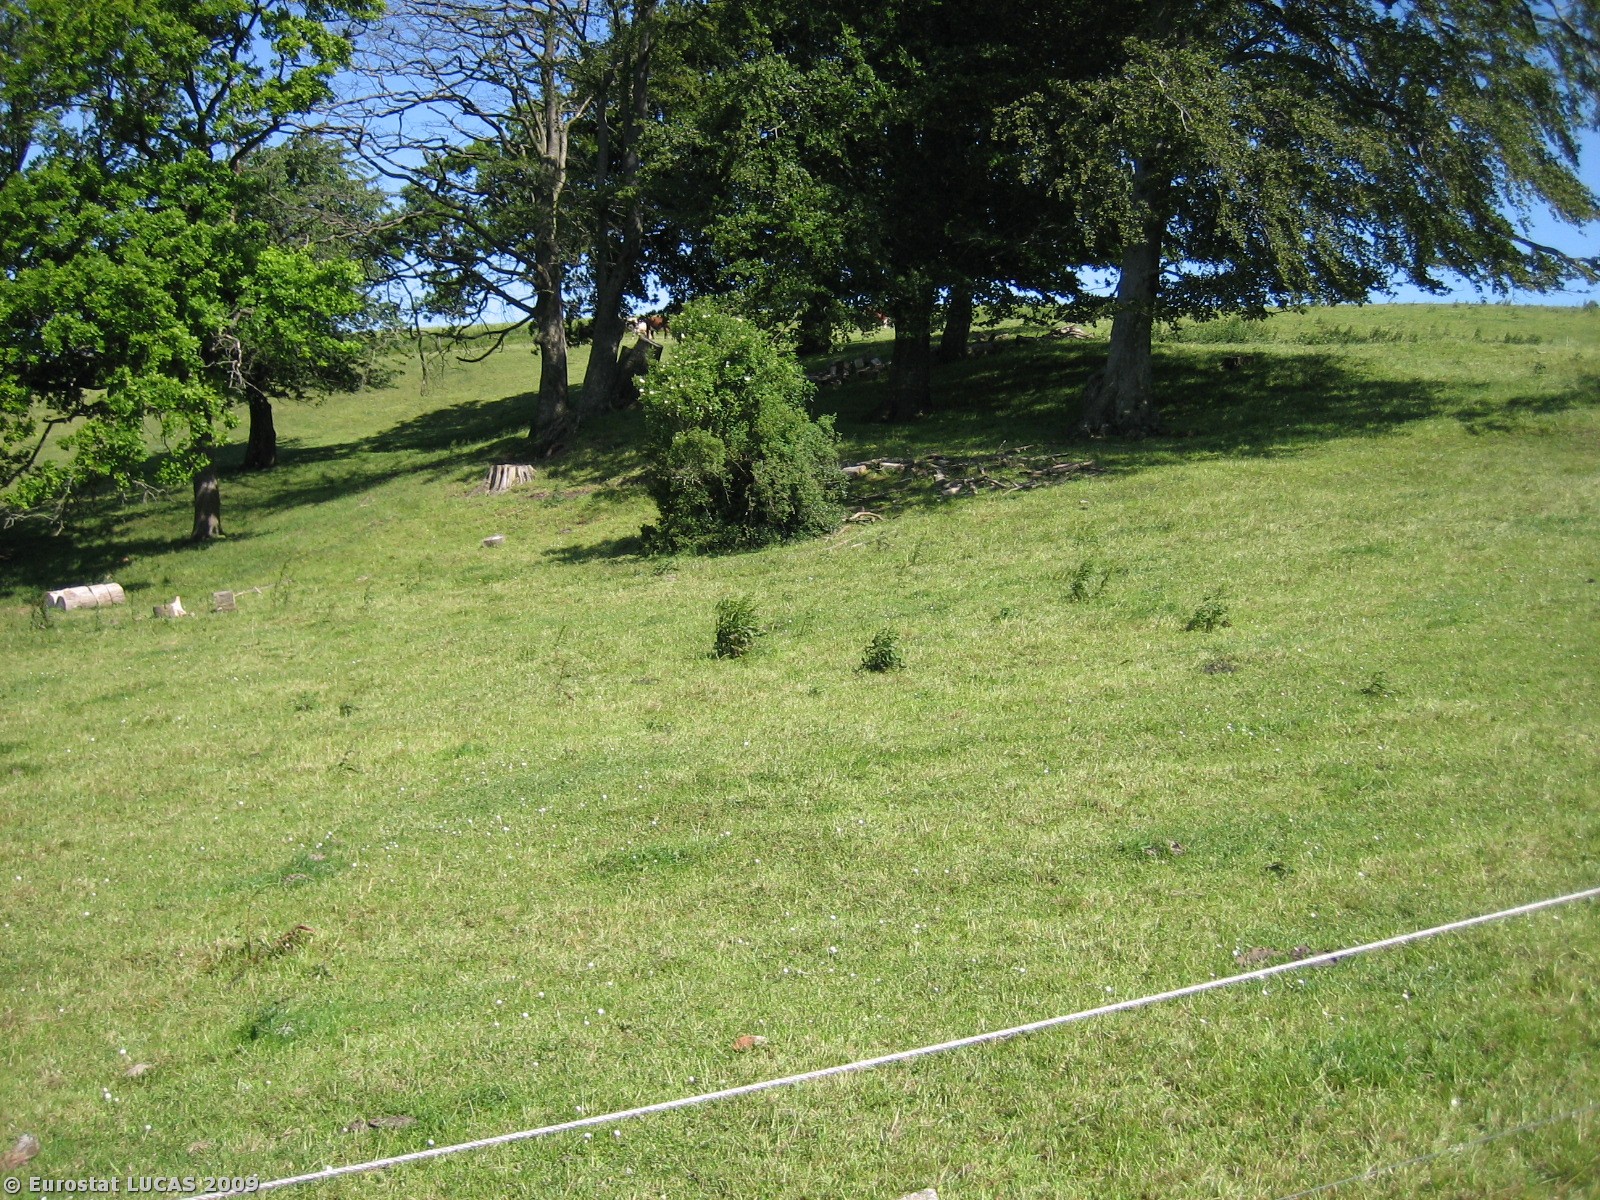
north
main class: Grassland
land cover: Grassland without tree/shrub cover
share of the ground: > 75 %
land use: Agriculture (excluding fallow land and kitchen gardens)
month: June
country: DK
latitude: 55.9720
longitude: 9.9200
